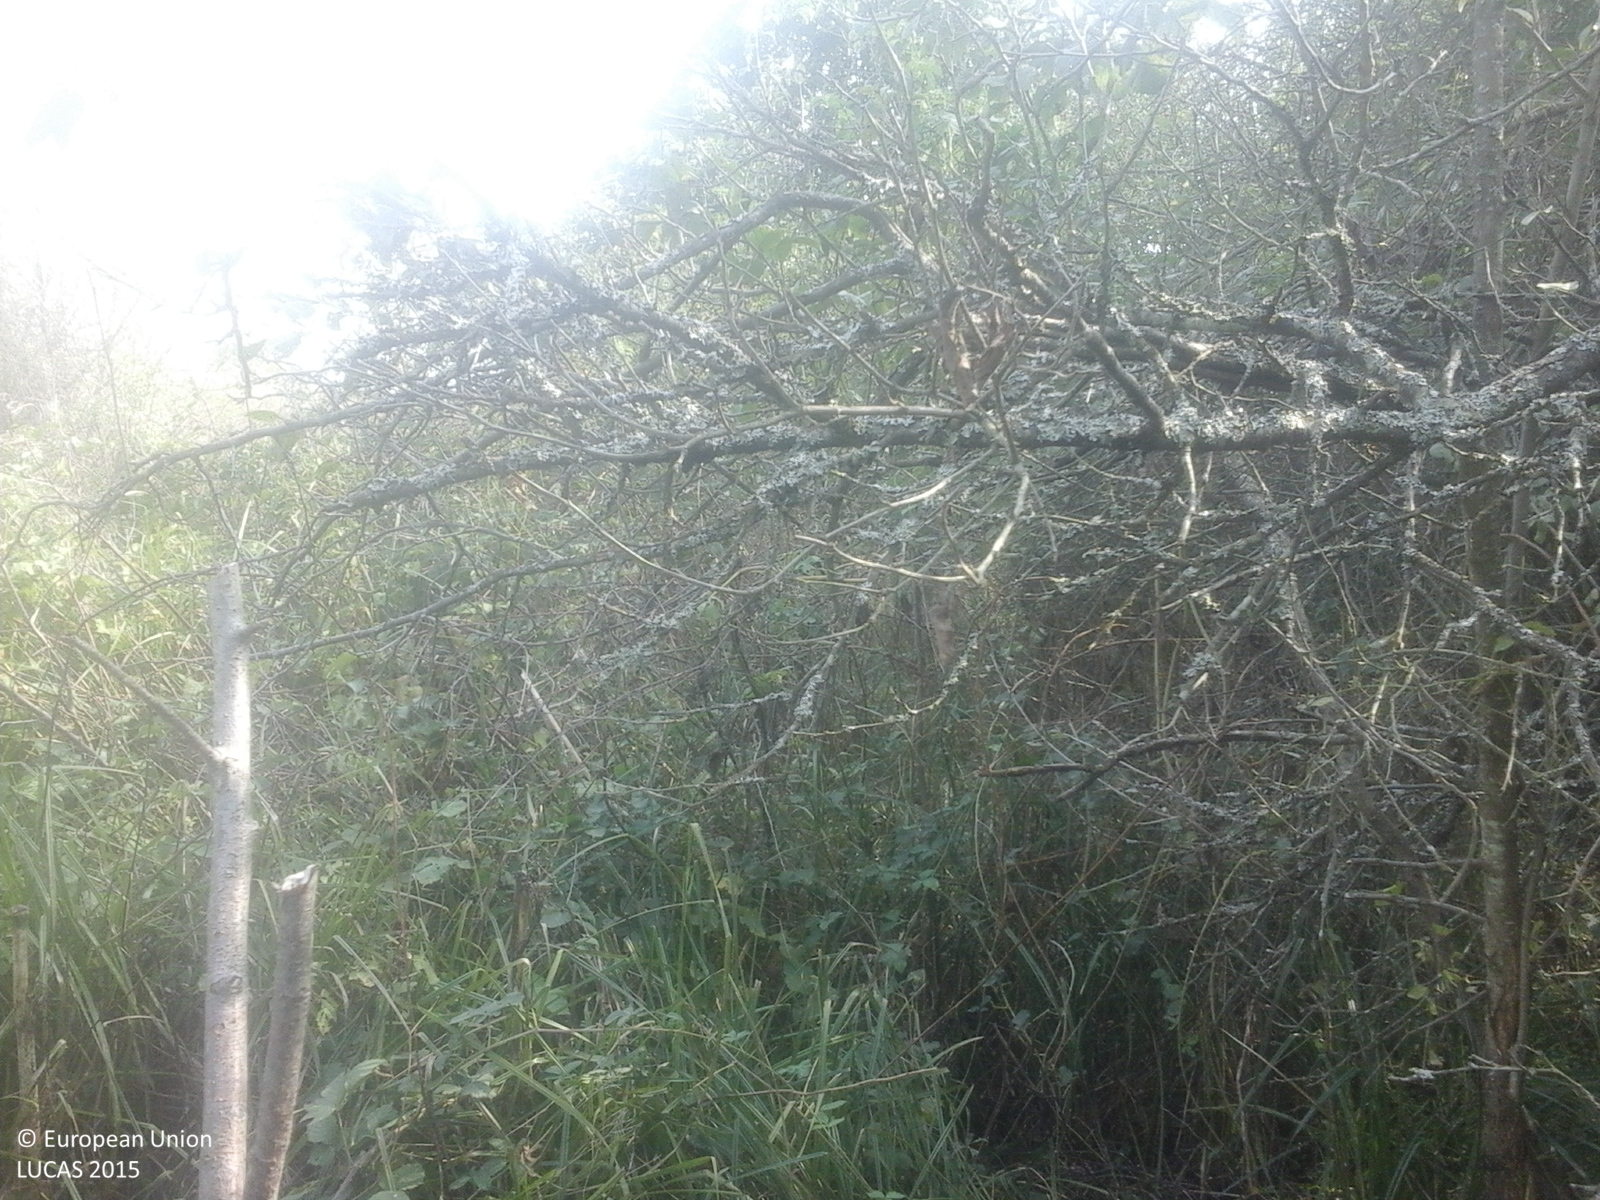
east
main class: Shrubland
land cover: Shrubland with sparse tree cover
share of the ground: > 75 %
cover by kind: shrubs 95 %, broadleaved forest trees 5 %
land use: Forestry
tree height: < 5 m
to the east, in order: Shrubland with sparse tree cover; Rivers and streams; Shrubland with sparse tree cover; Spontaneously vegetated surfaces; Other bare soil; Grassland without tree/shrub cover; Grassland with sparse tree/shrub cover
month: September
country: RO
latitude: 45.8191
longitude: 22.1537
